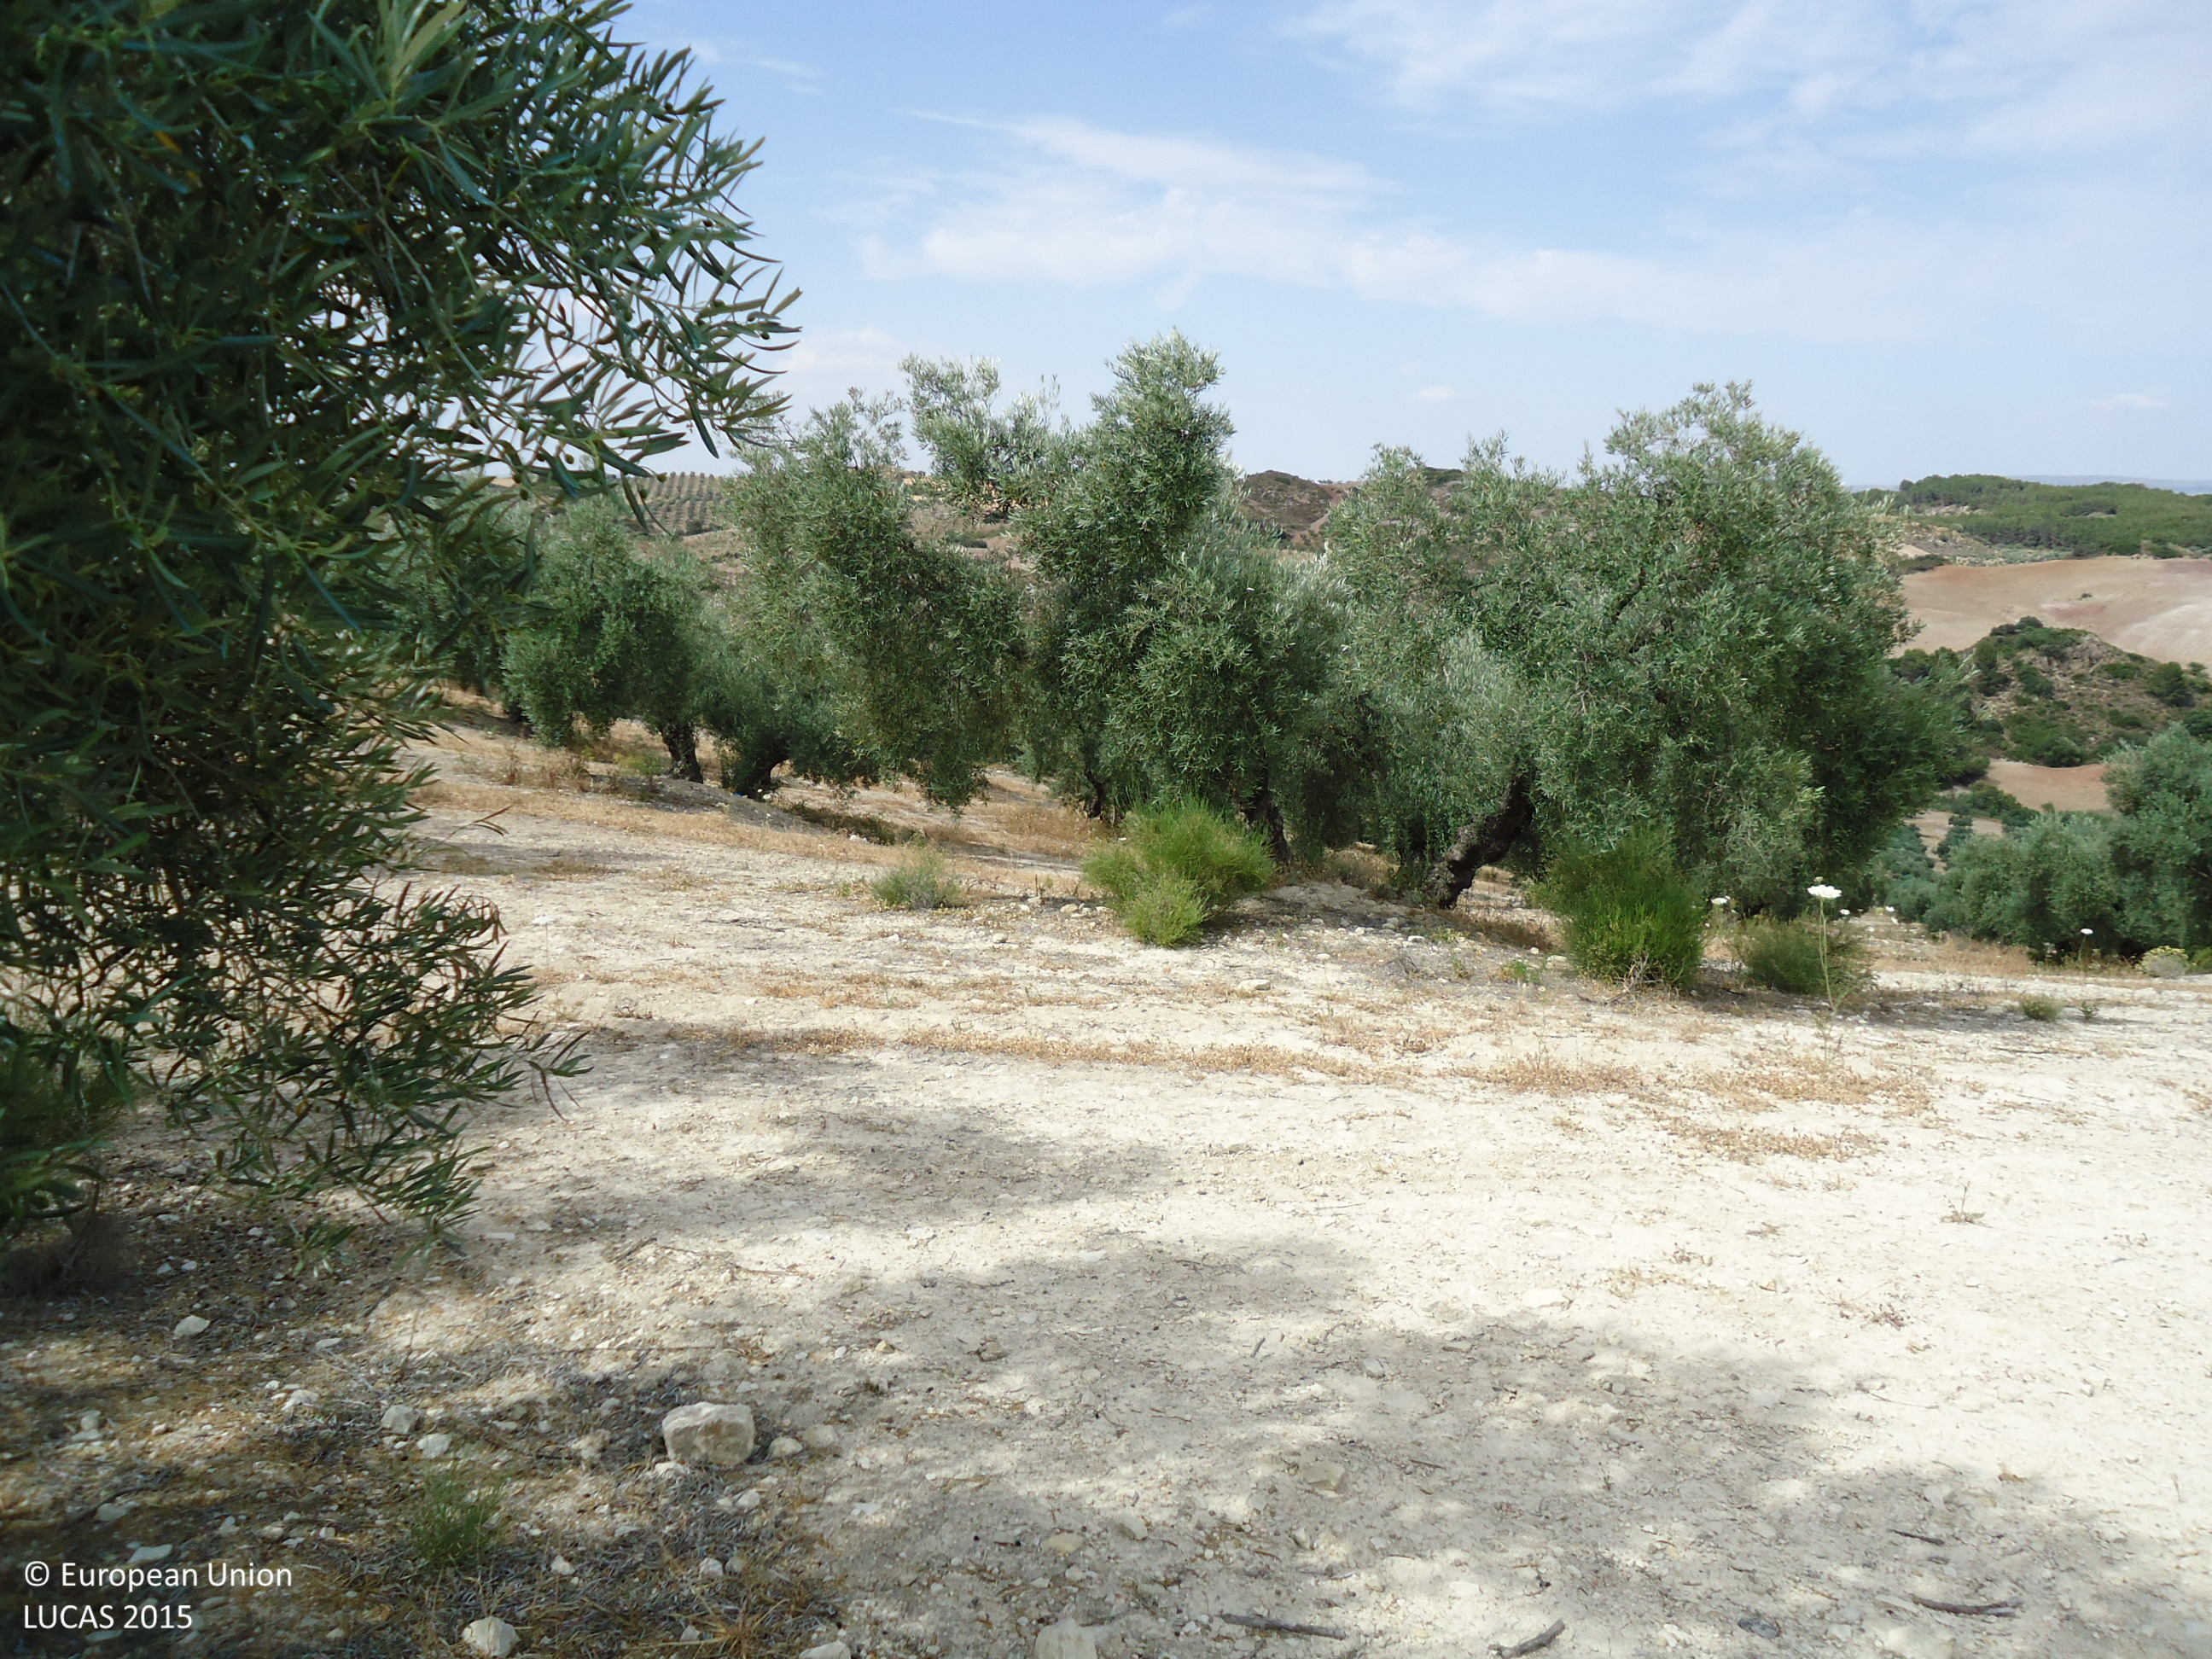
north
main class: Cropland
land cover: Olive groves
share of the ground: 25 - 50 %
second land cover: Other bare soil
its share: > 75 %
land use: Agriculture (excluding fallow land and kitchen gardens)
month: June
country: ES
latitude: 36.9845
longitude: -4.8178
